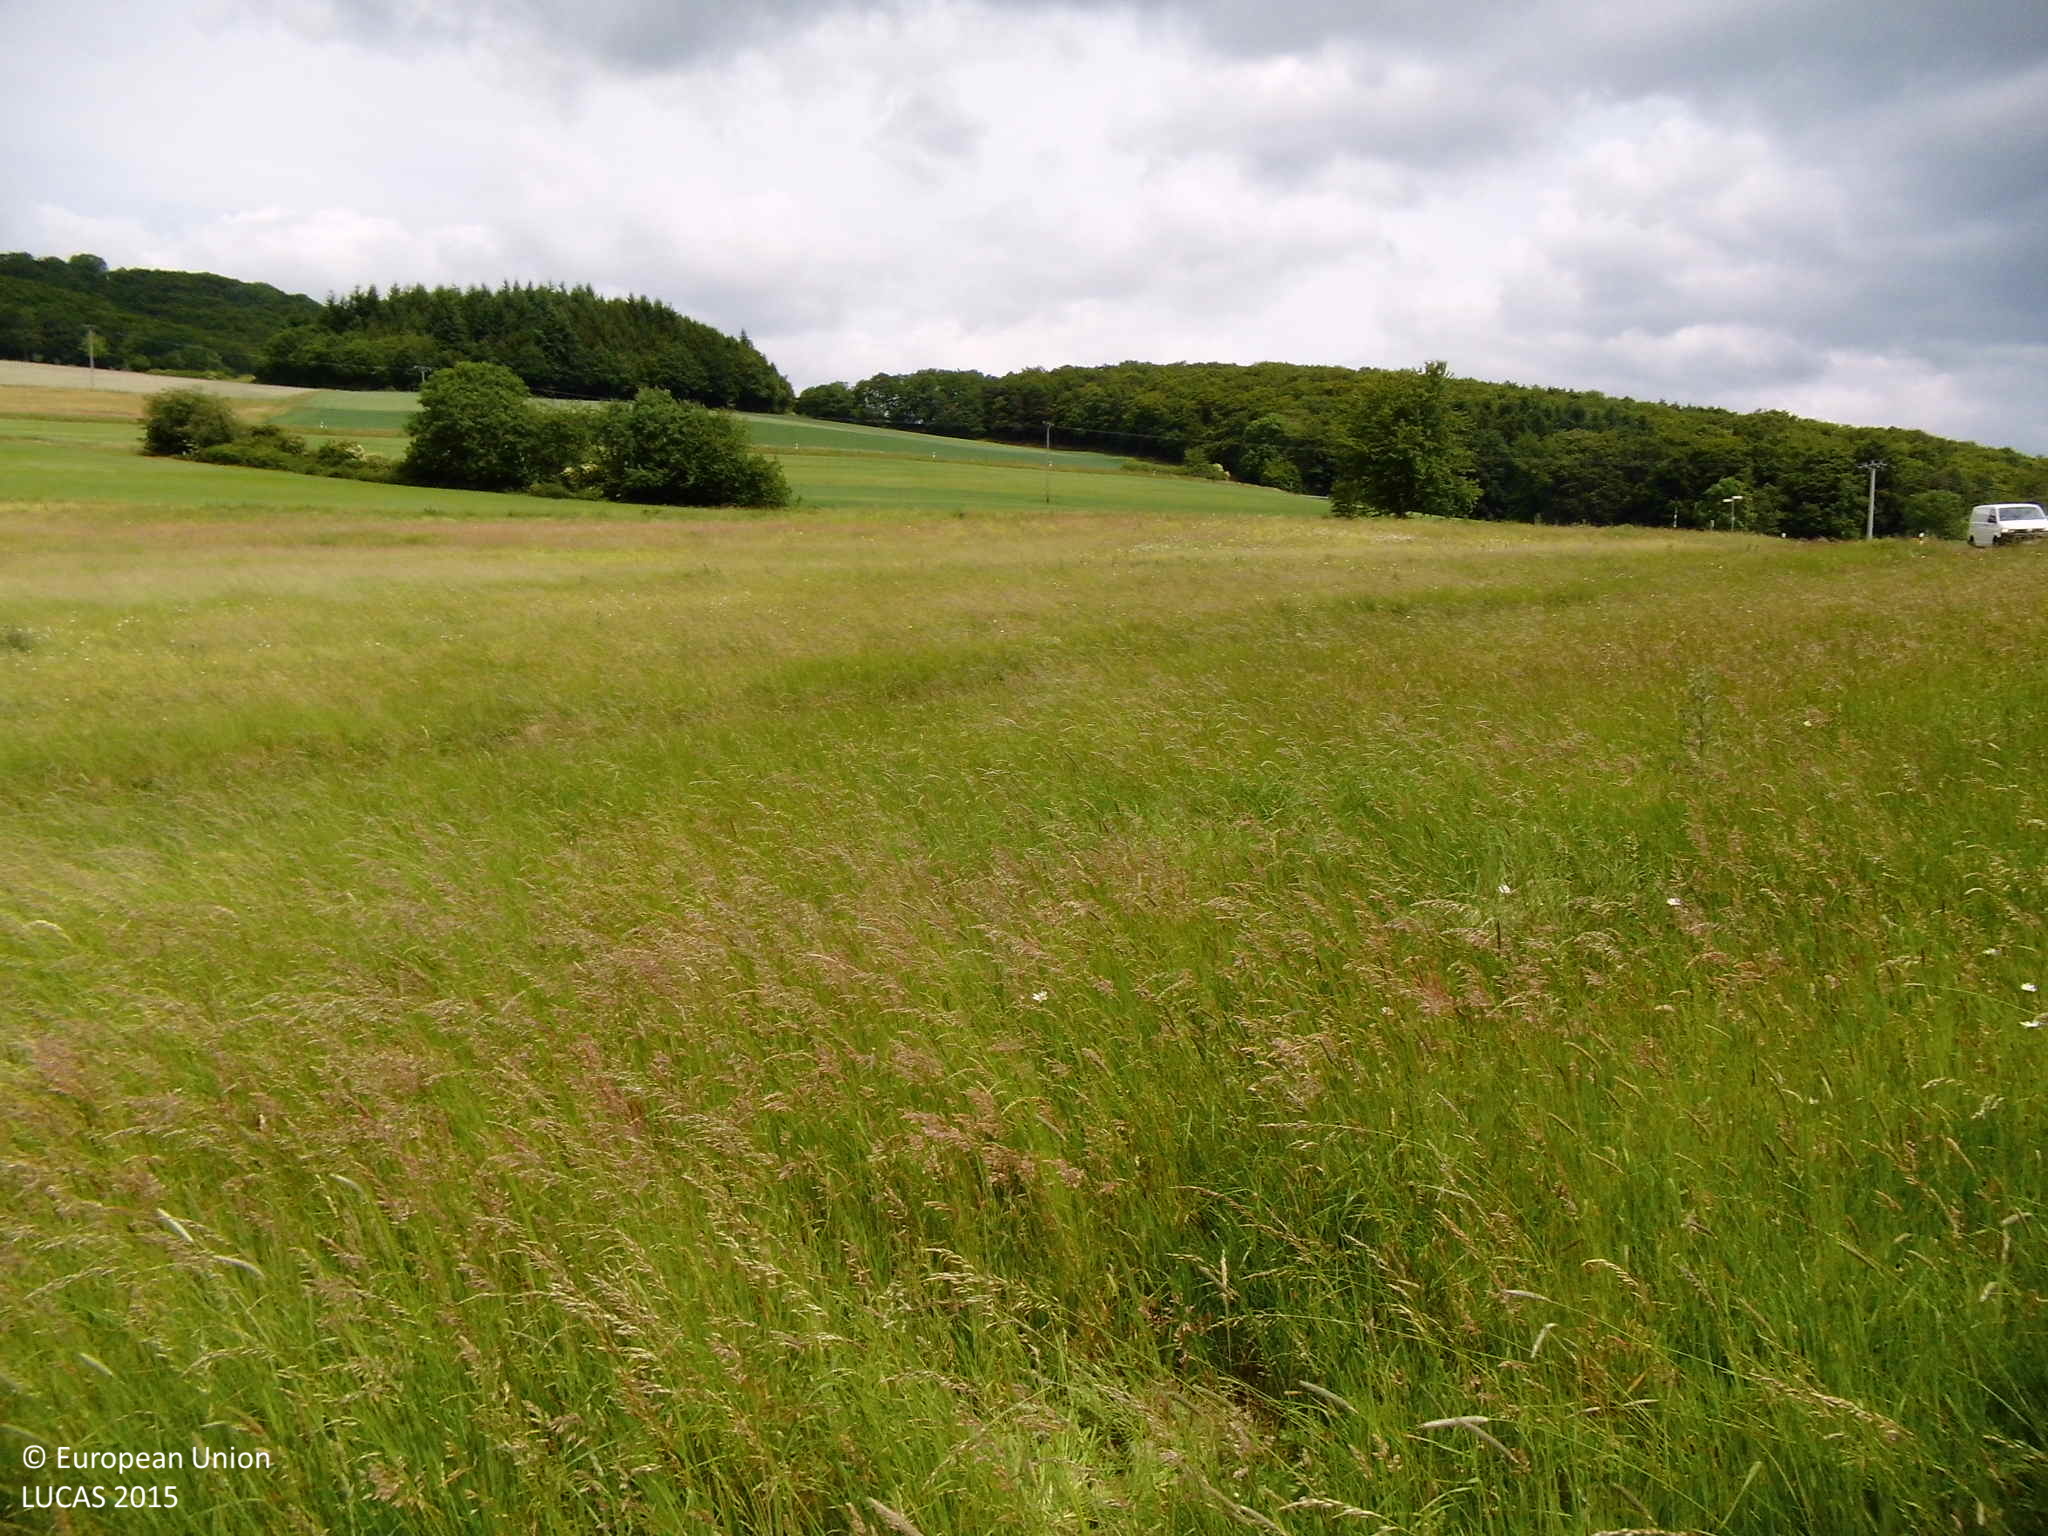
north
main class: Grassland
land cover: Grassland without tree/shrub cover
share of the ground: > 75 %
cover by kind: herbaceous plants 100 %
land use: Agriculture (excluding fallow land and kitchen gardens)
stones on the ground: 25 - 50 %
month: June
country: DE
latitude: 50.7863
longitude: 8.5394
